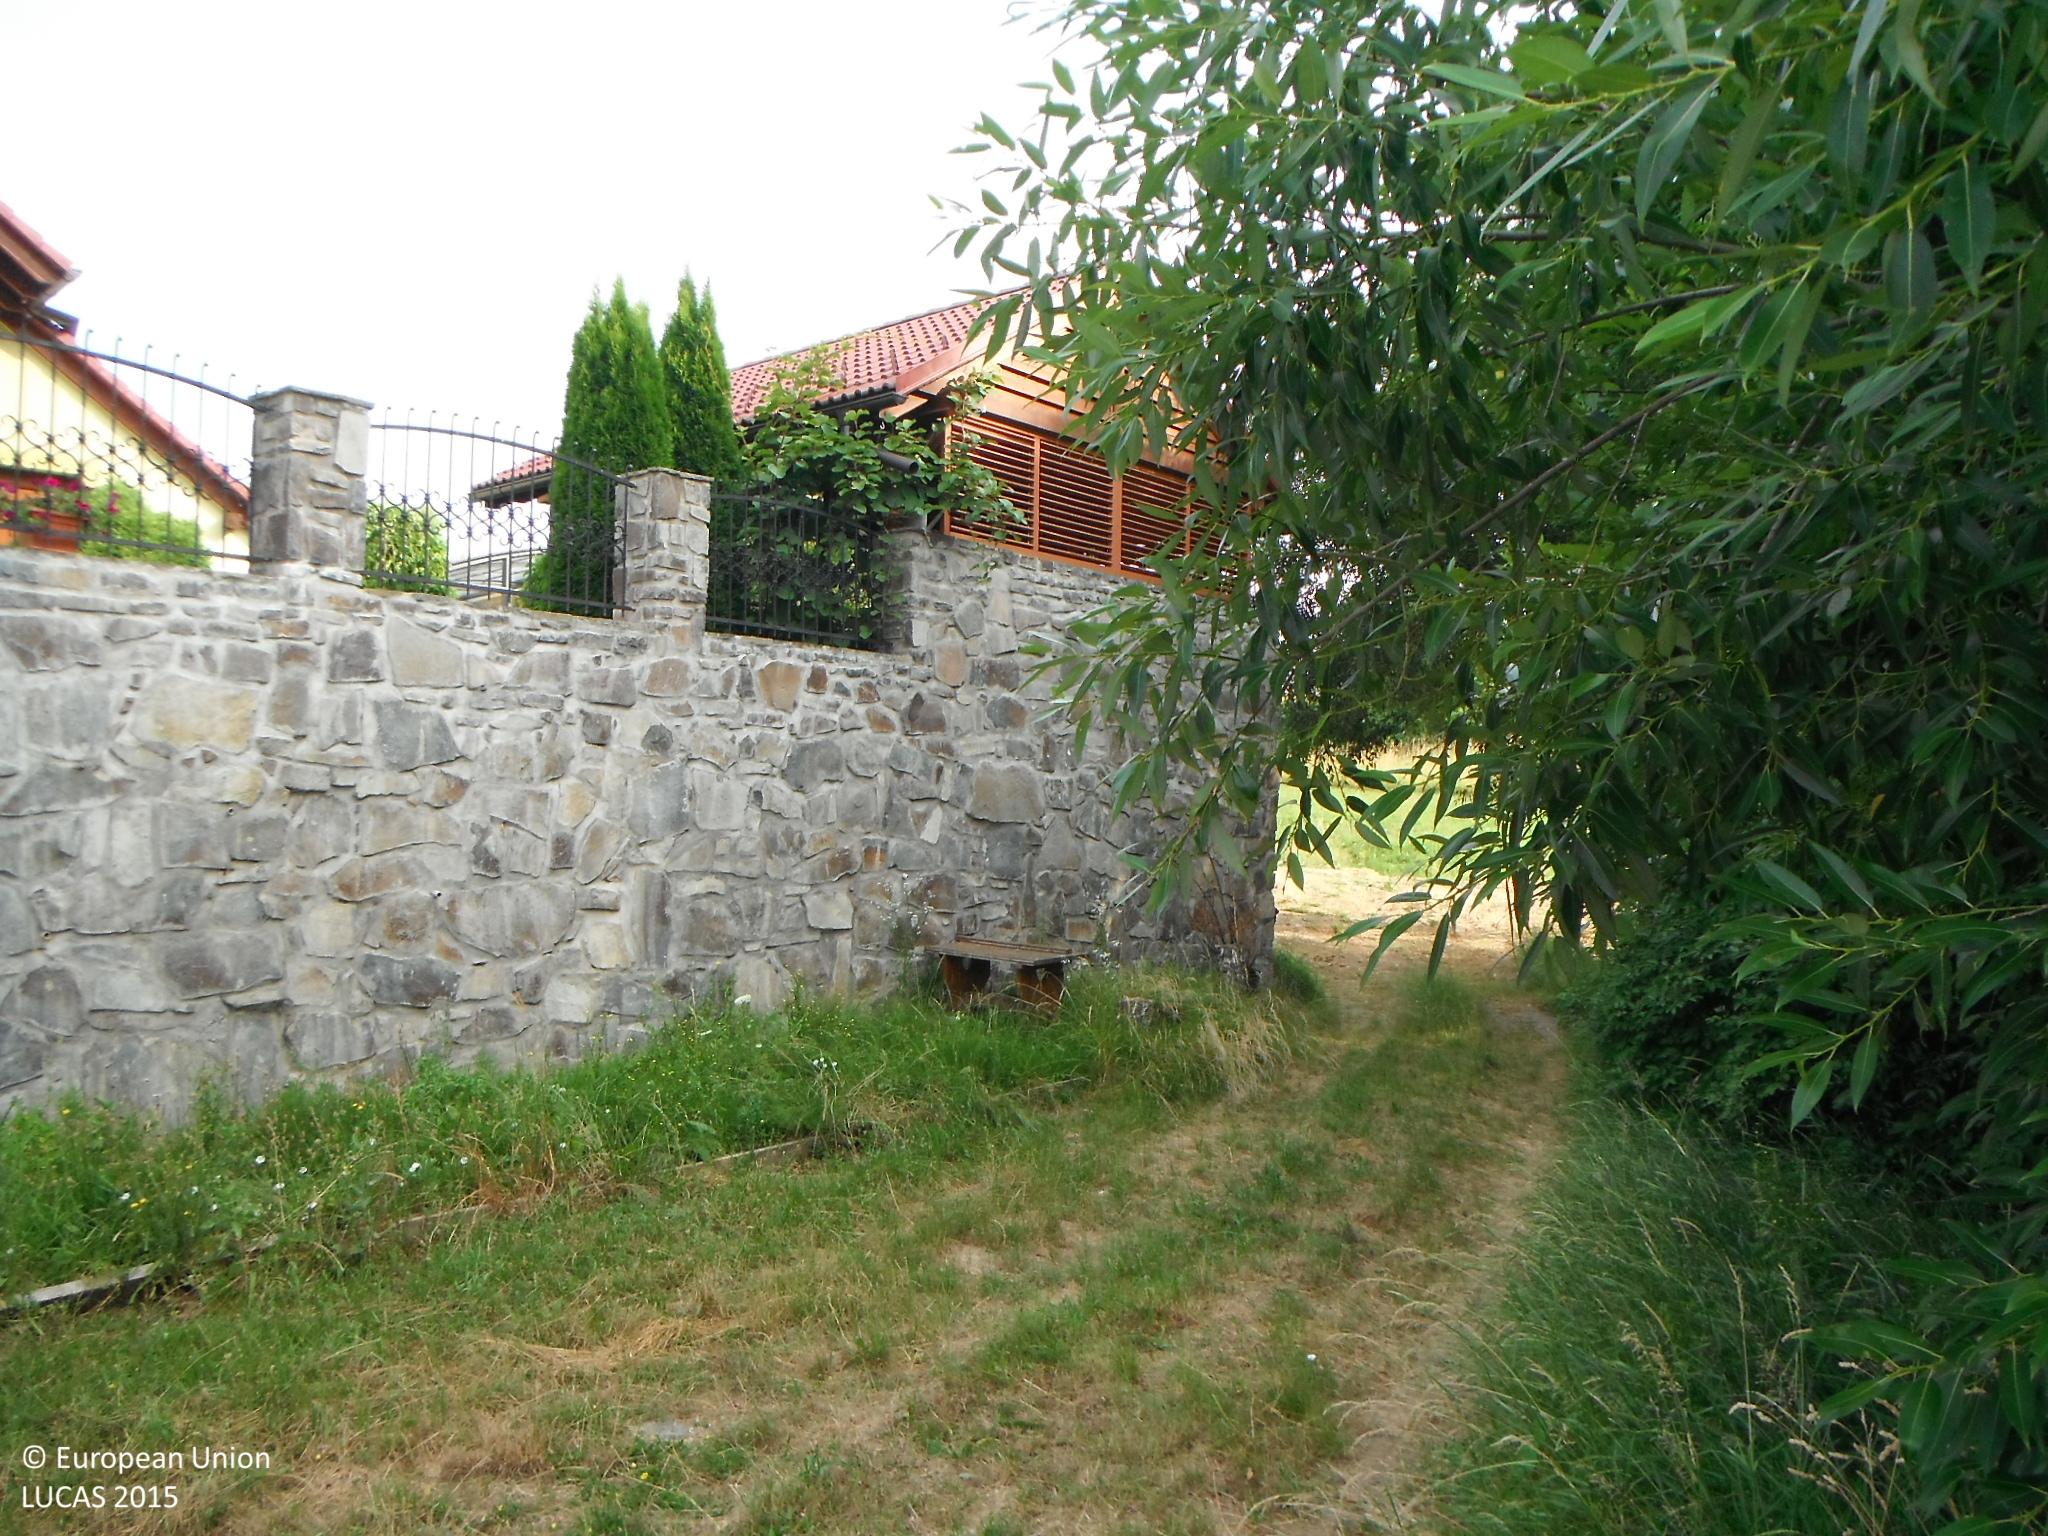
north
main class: Grassland
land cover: Grassland without tree/shrub cover
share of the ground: > 75 %
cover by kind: herbaceous plants 100 %
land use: Agriculture (excluding fallow land and kitchen gardens)
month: July
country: SK
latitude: 48.5851
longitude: 19.1455
